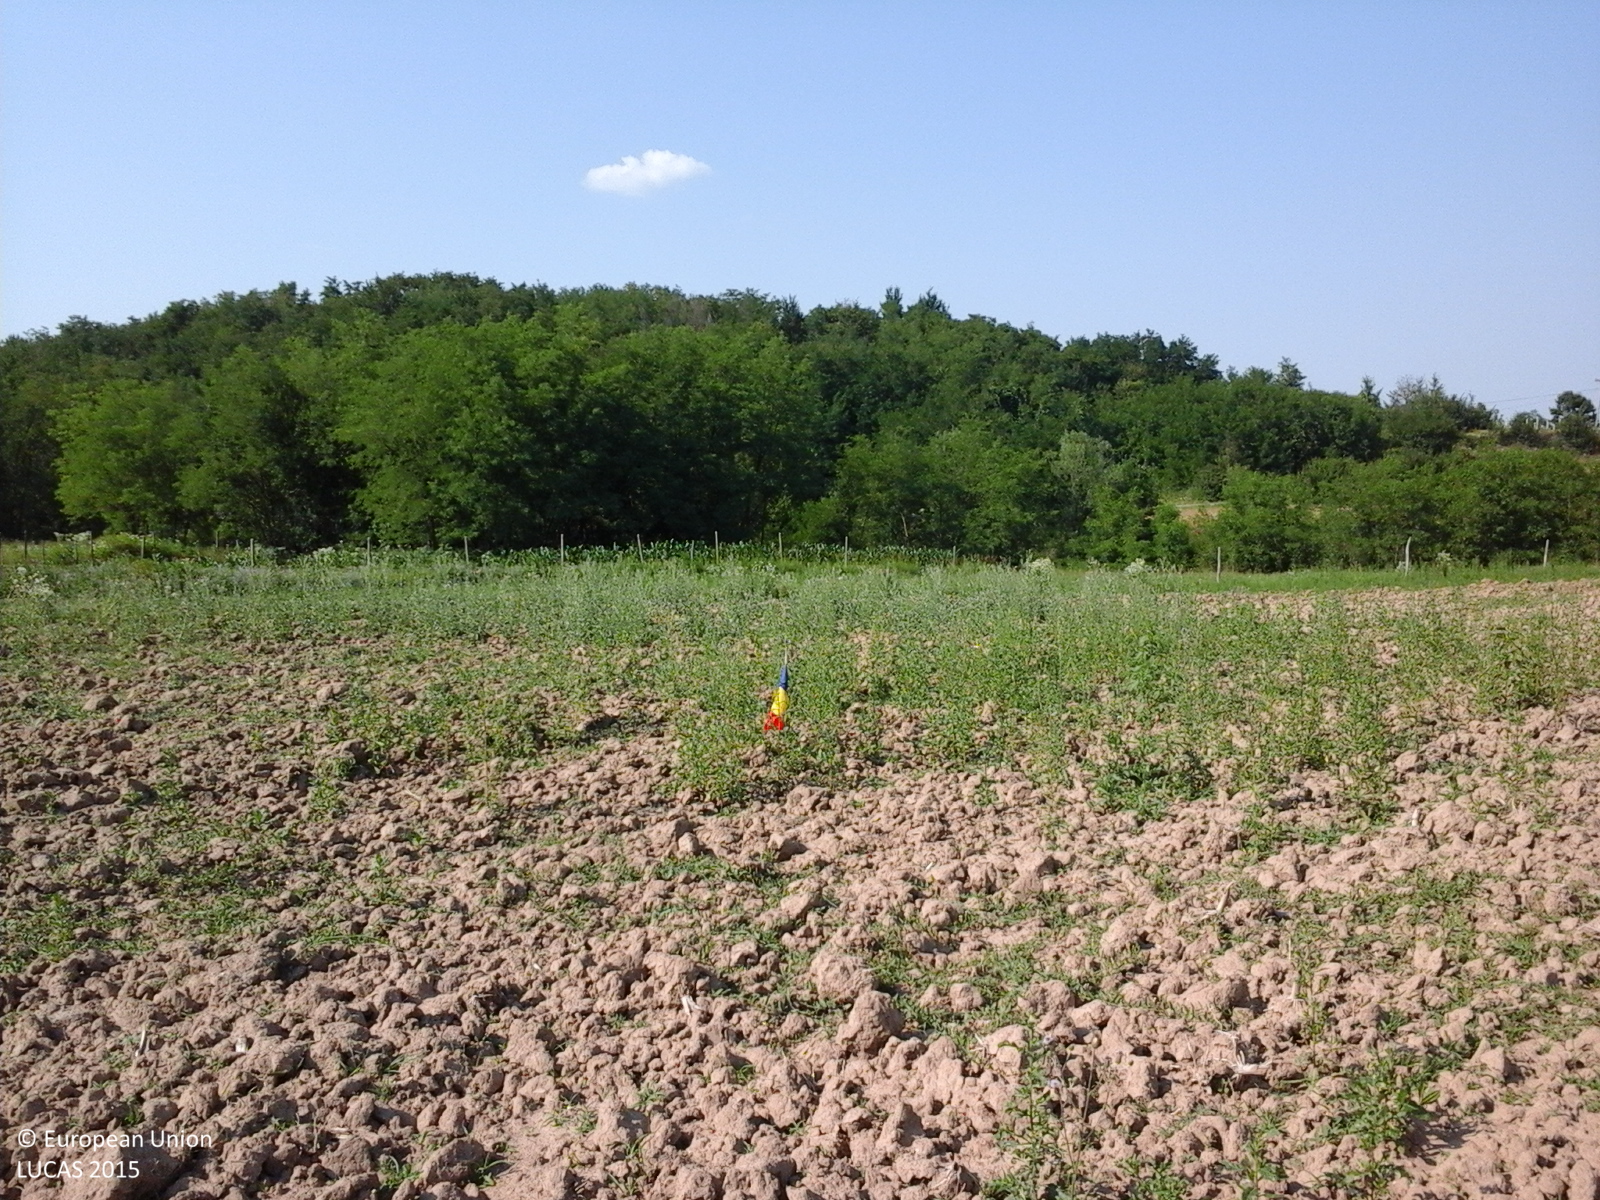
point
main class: Grassland
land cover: Spontaneously vegetated surfaces
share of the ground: 10 - 25 %
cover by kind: unconsolidated bare surface 85 %, herbaceous plants 15 %
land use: Agriculture (excluding fallow land and kitchen gardens)
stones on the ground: < 10 %
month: July
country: RO
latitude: 44.6952
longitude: 24.6509
